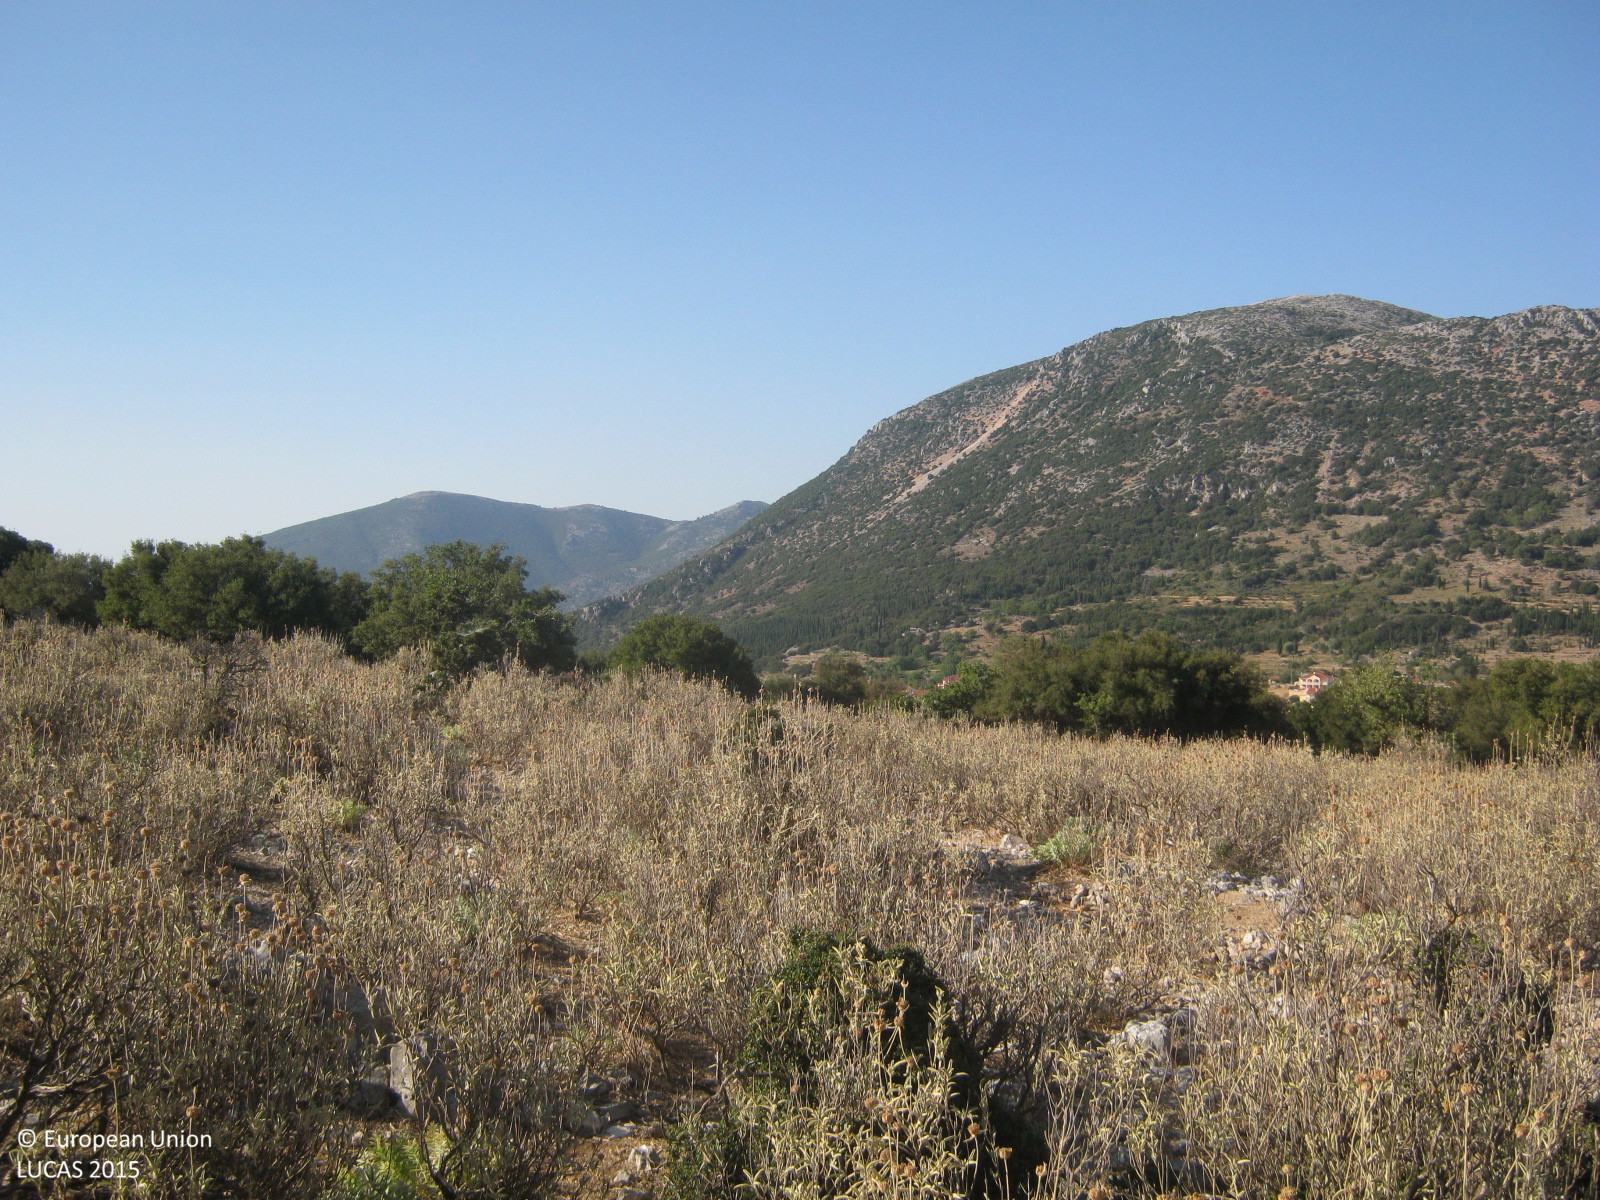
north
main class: Grassland
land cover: Grassland with sparse tree/shrub cover
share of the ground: > 75 %
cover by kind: herbaceous plants 75 %, shrubs 10 %, consolidated bare surface 10 %, broadleaved forest trees 5 %
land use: Semi-natural and natural areas not in use
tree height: < 5 m
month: July
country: GR
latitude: 38.1678
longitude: 20.6791
